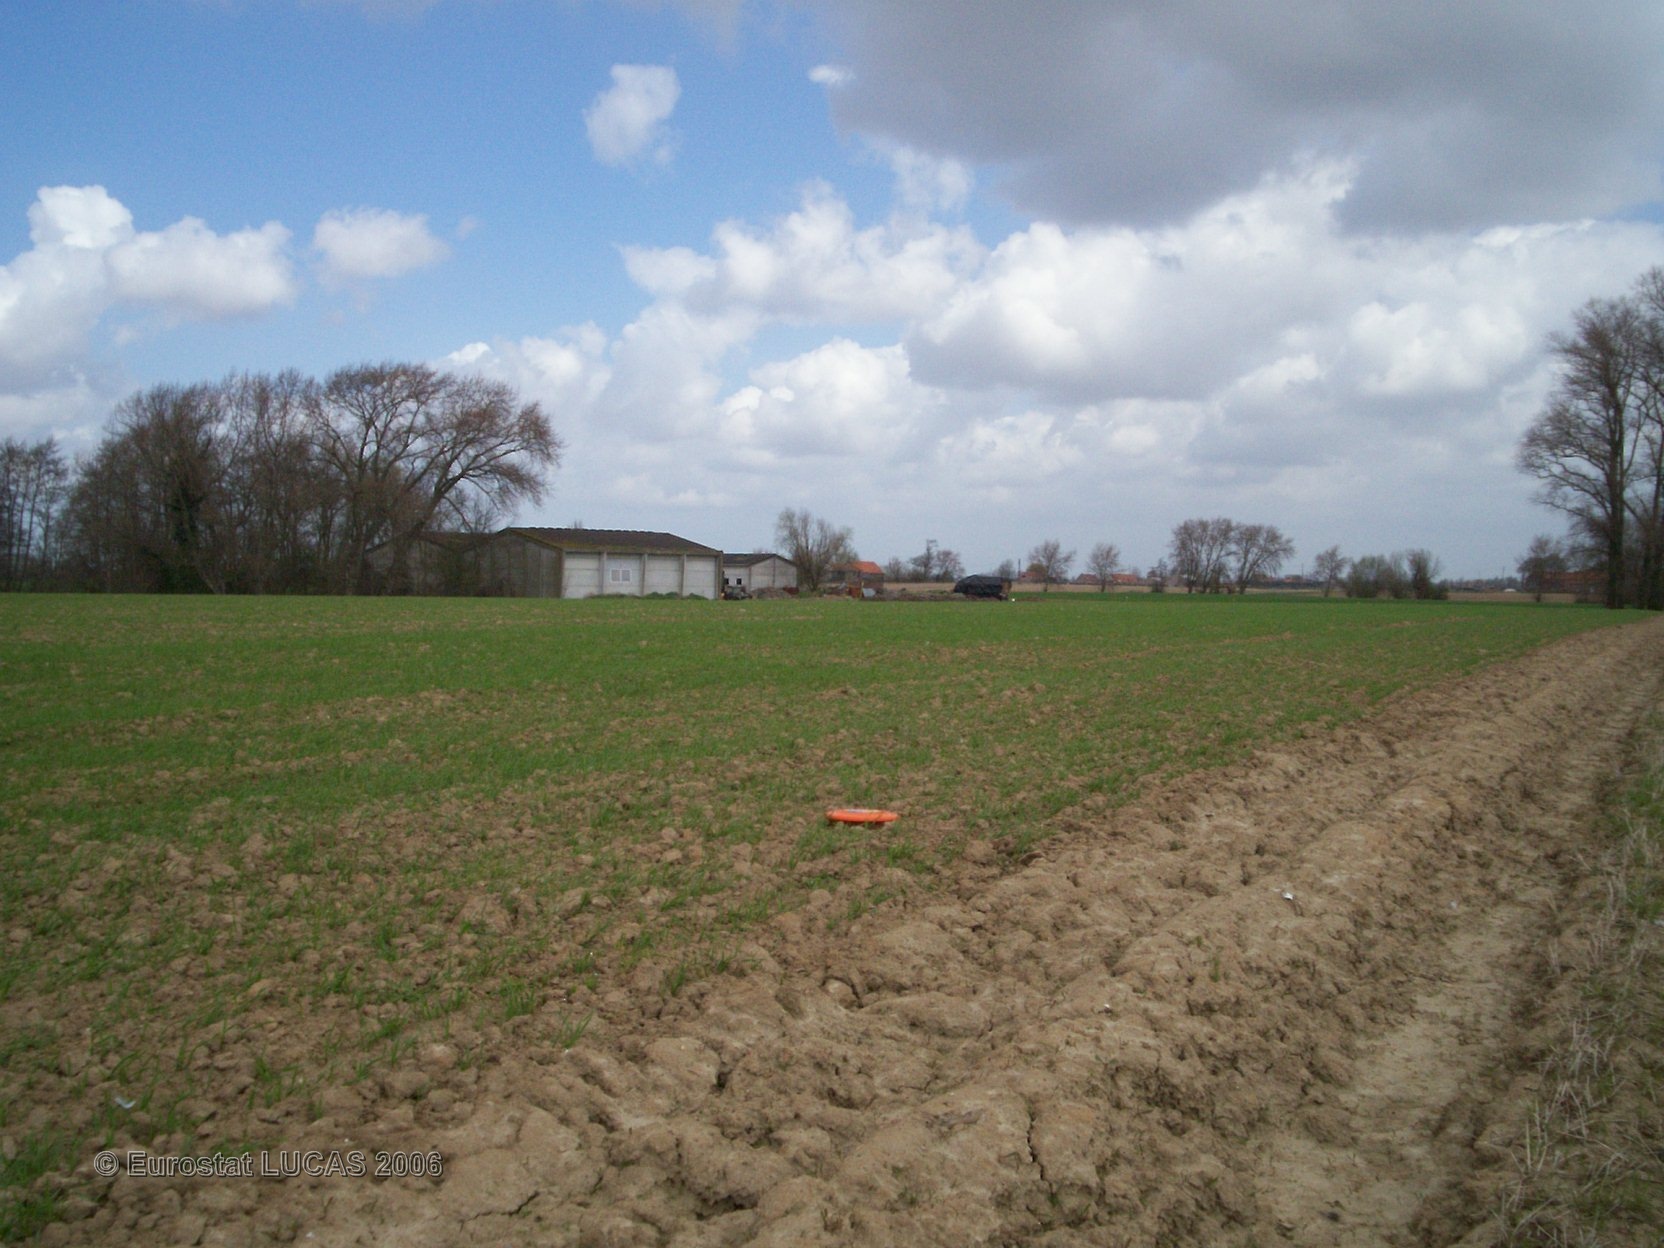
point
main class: Cropland
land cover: Common wheat
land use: Agriculture (excluding fallow land and kitchen gardens)
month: April
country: FR
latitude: 50.8581
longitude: 2.5005
